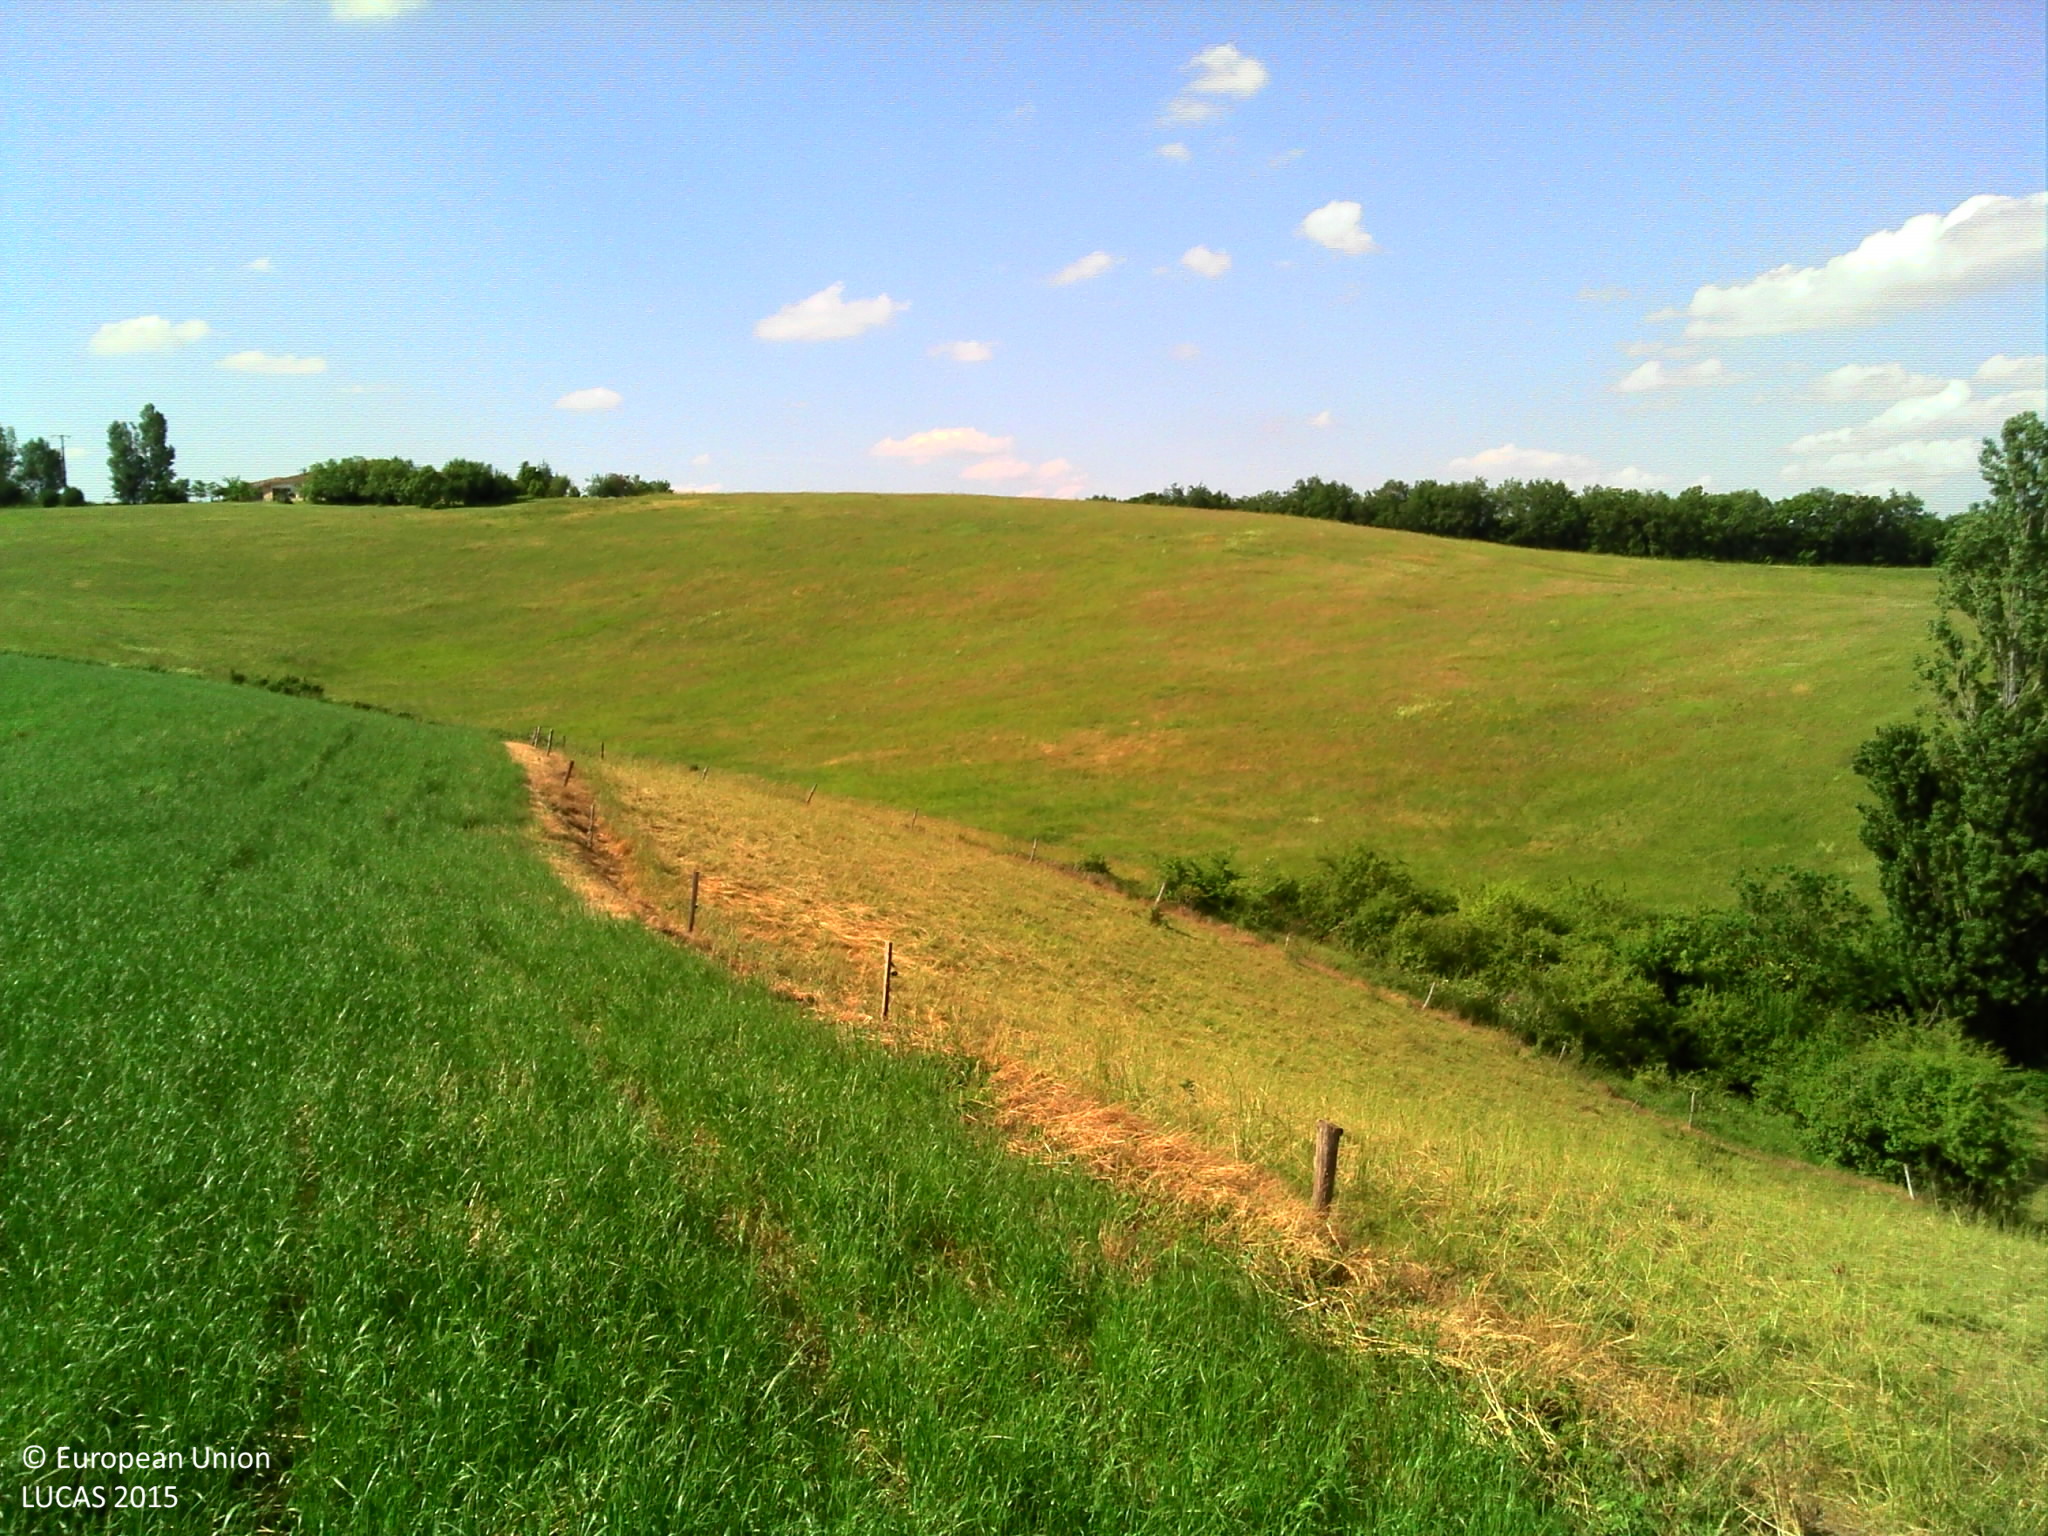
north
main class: Cropland
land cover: Temporary grasslands
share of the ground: > 75 %
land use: Agriculture (excluding fallow land and kitchen gardens)
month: June
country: FR
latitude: 43.4976
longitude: 0.7117
